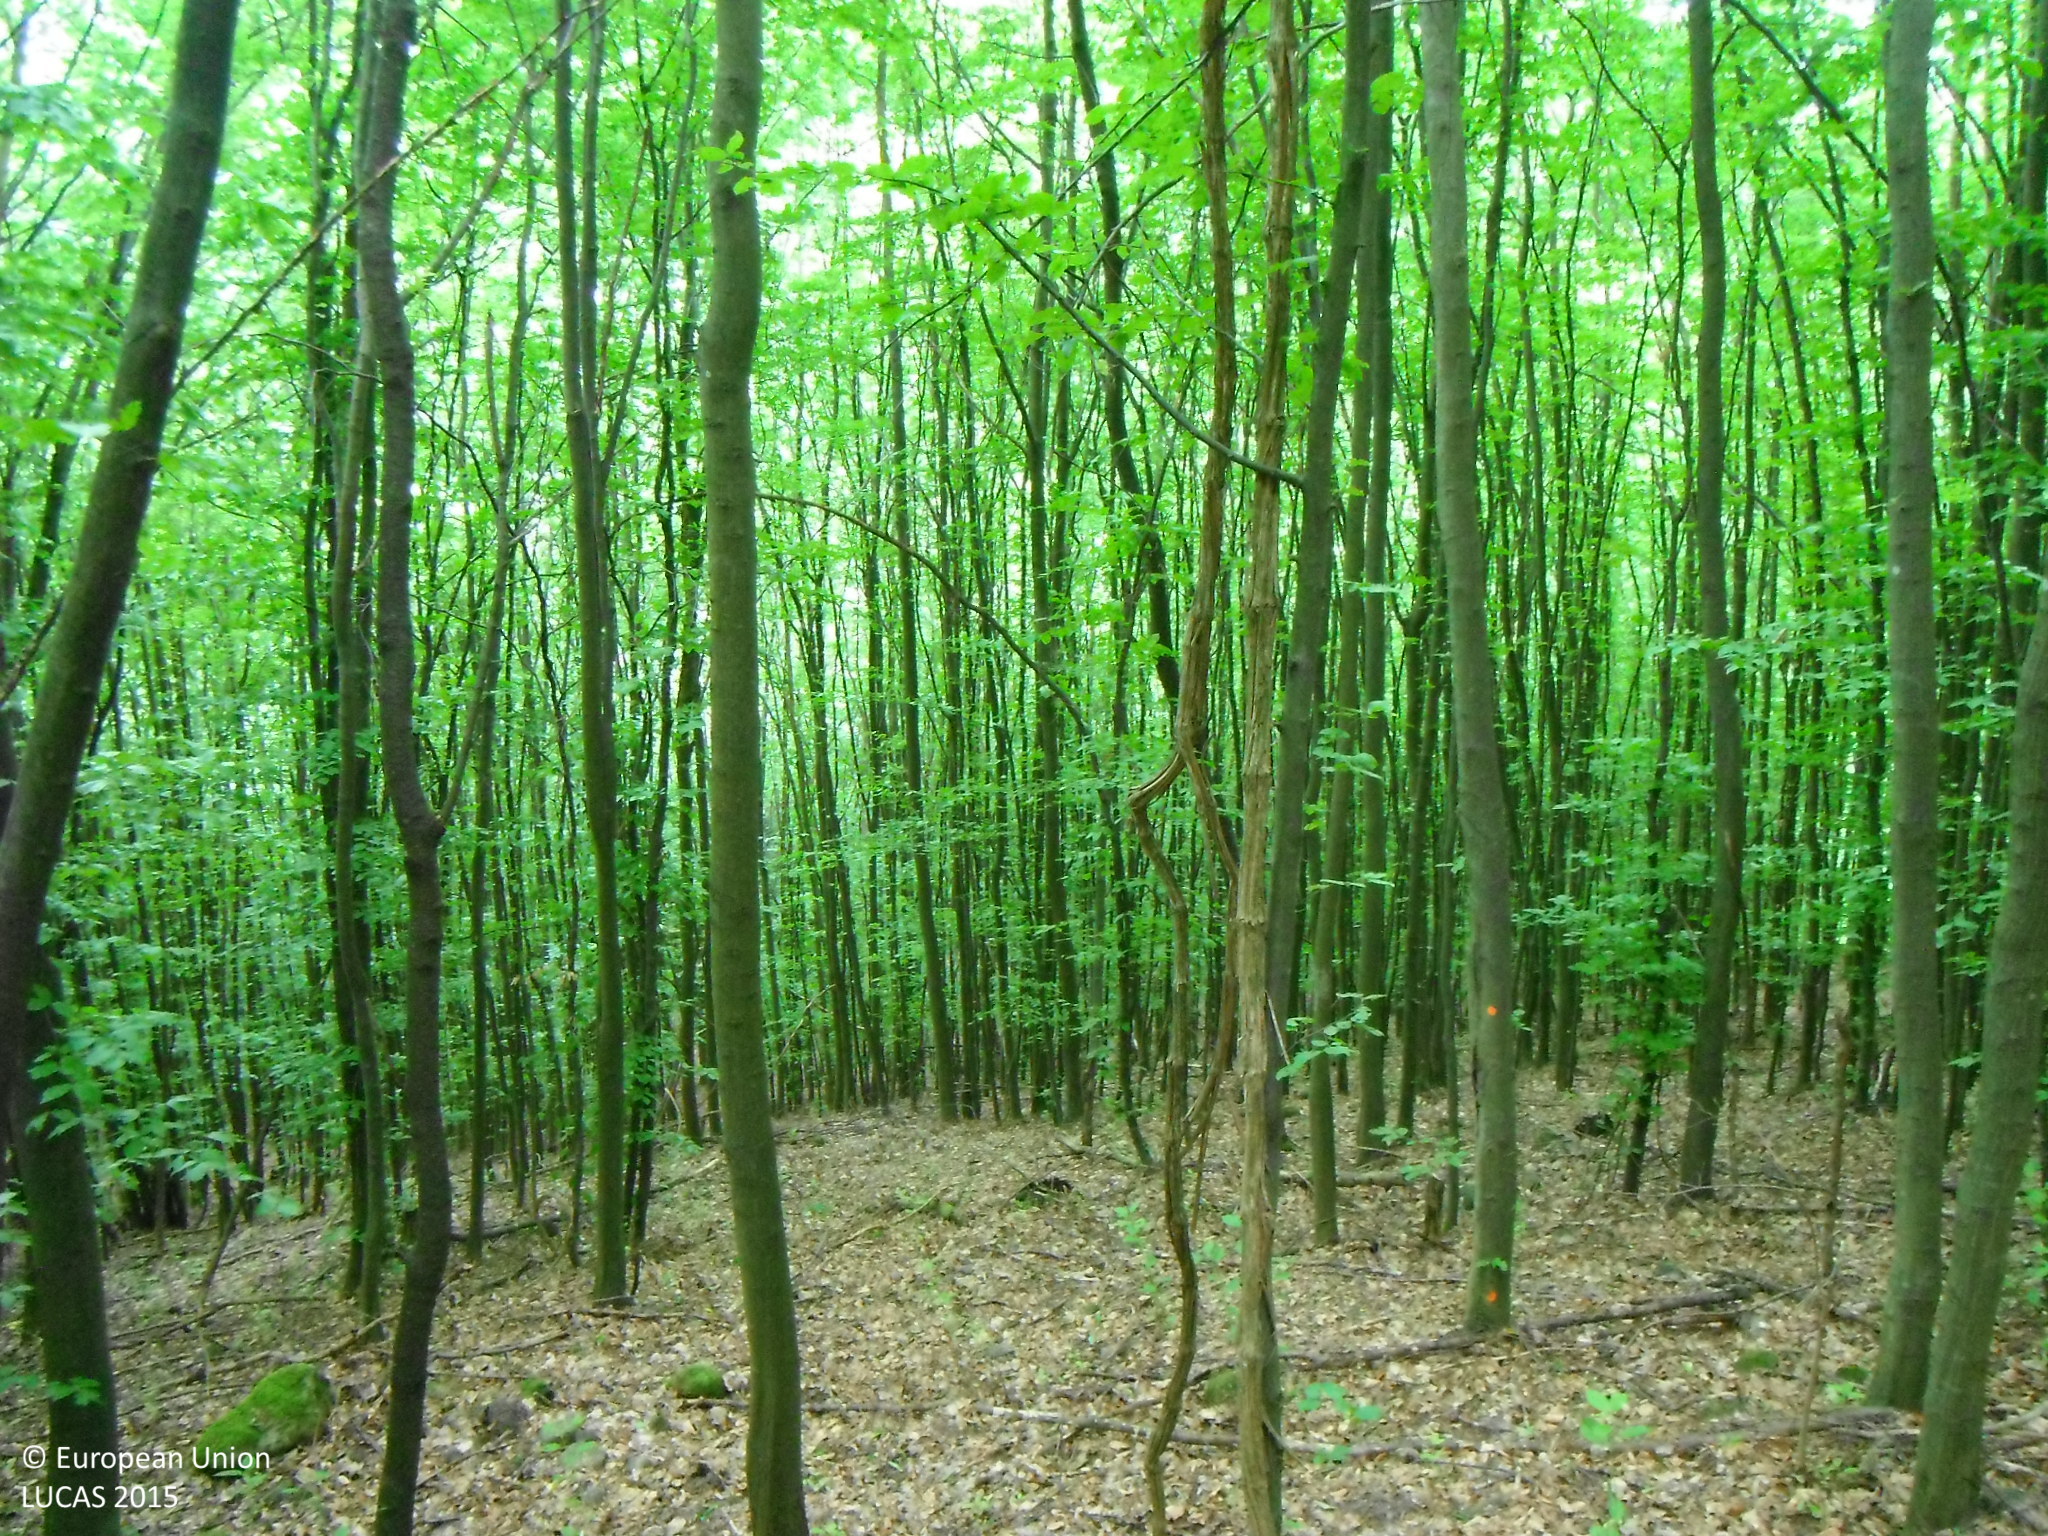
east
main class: Woodland
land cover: Broadleaved woodland
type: beech forest
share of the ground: > 75 %
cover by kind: broadleaved forest trees 100 %
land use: Forestry
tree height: > 5 m
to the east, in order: Broadleaved woodland; Tracks; Broadleaved woodland; Spontaneously vegetated surfaces; Electric lines; Paved roads, cycling and walking lanes; Spontaneously vegetated surfaces; Broadleaved woodland; Rivers and streams; Broadleaved woodland
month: June
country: SK
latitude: 48.2685
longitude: 19.2507
